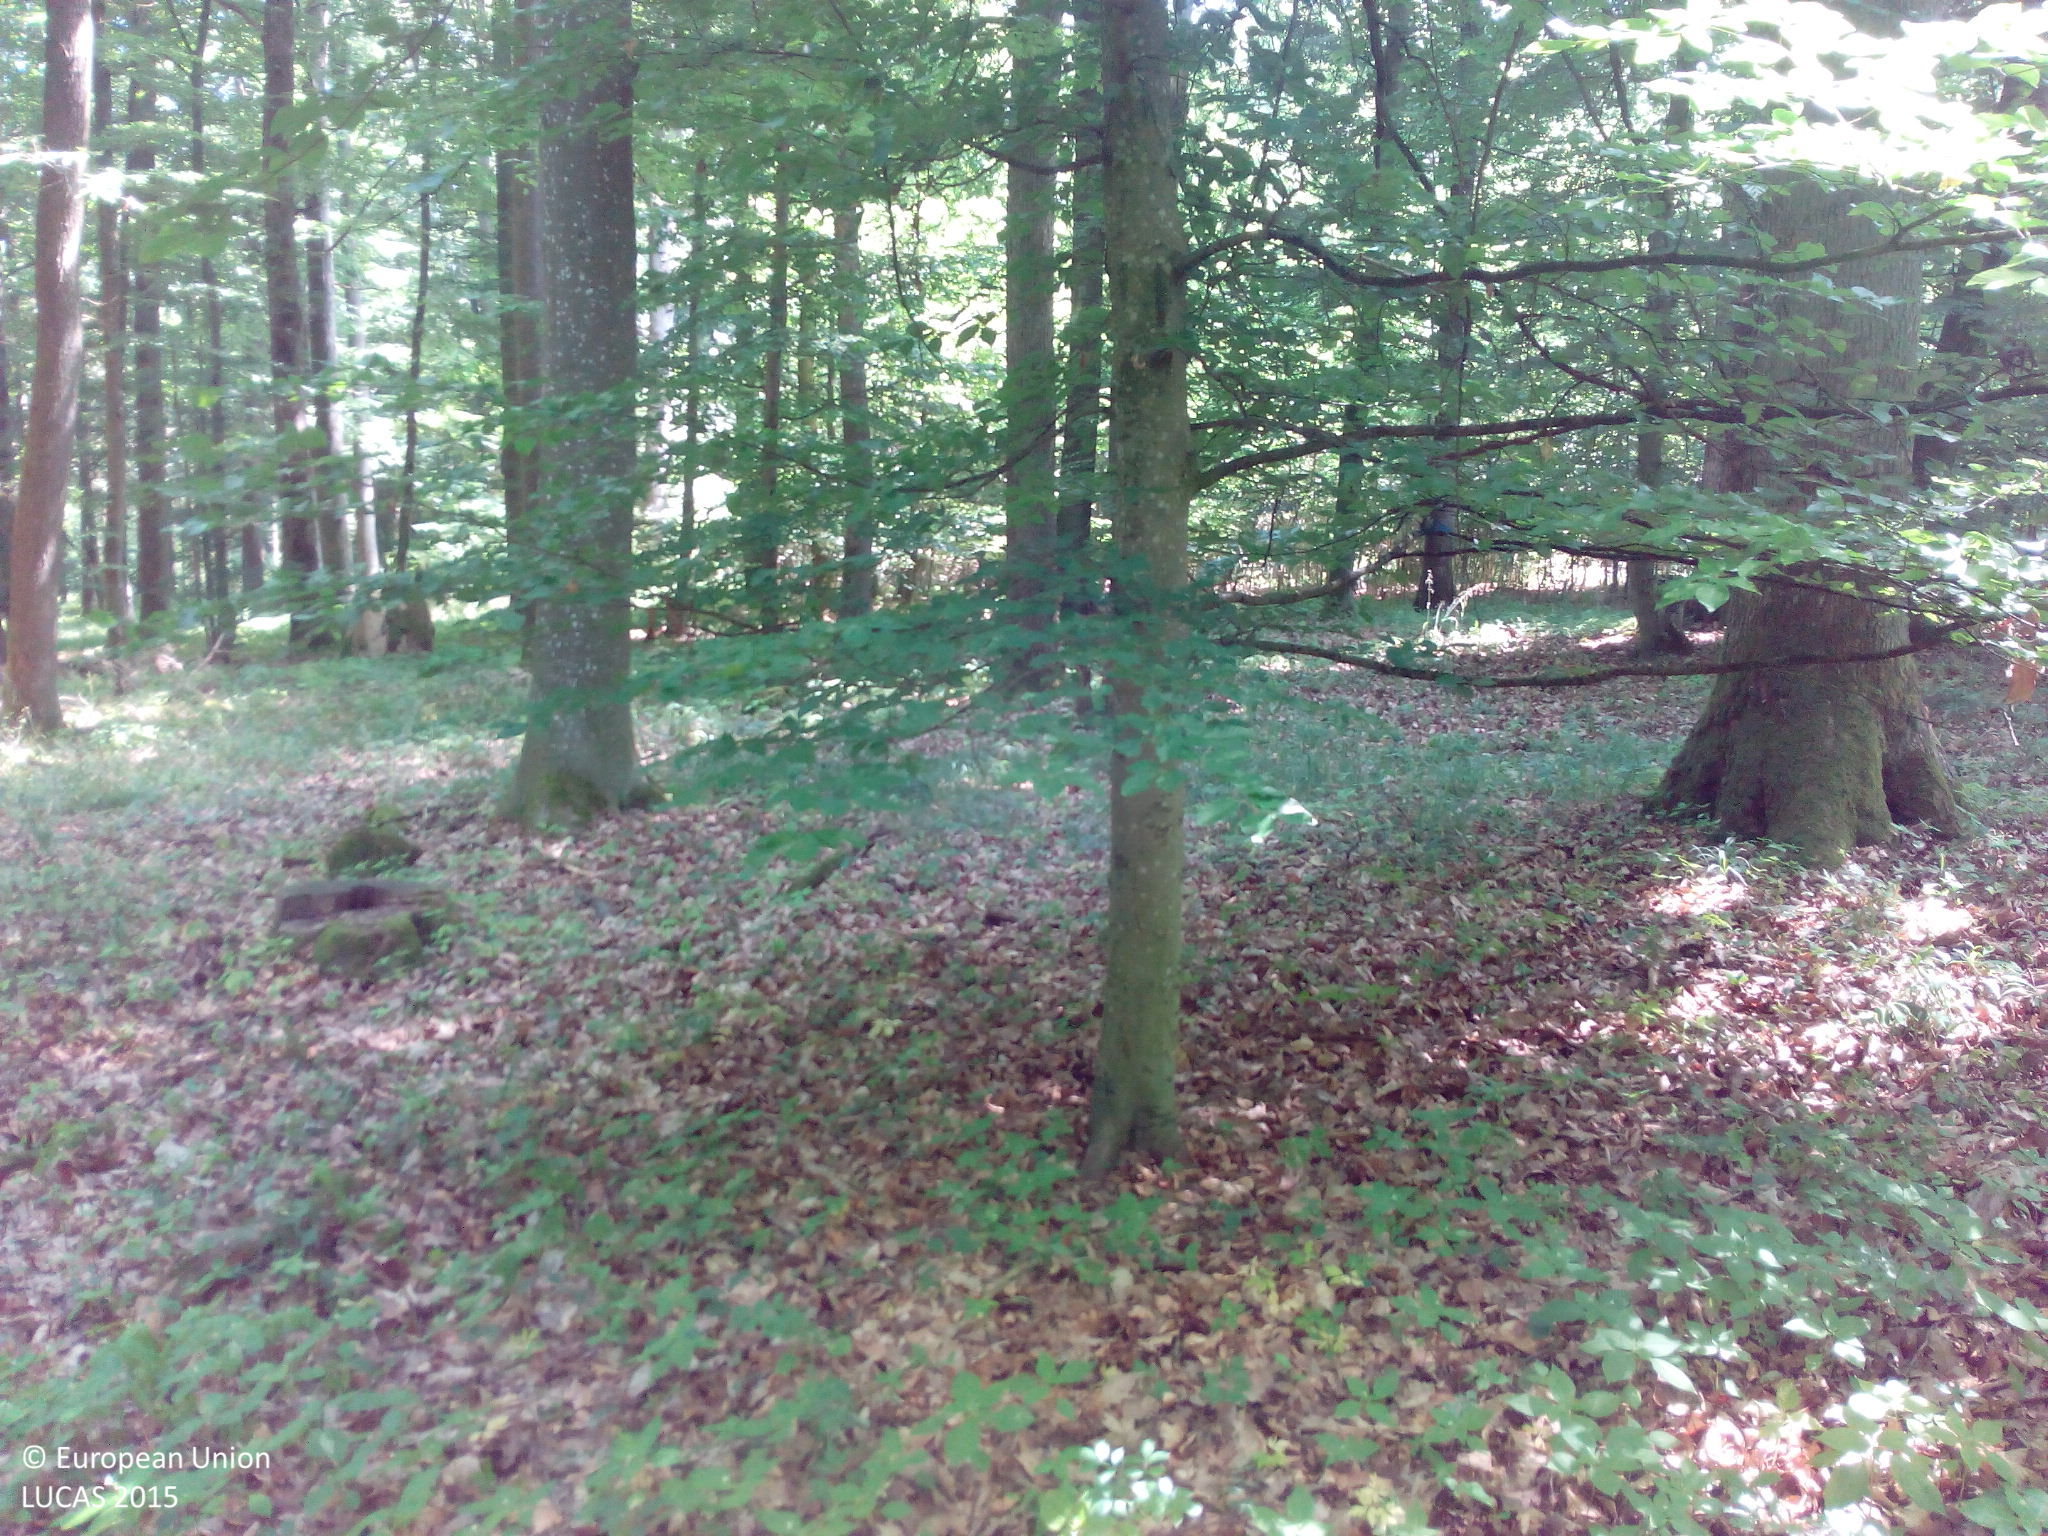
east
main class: Woodland
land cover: Broadleaved woodland
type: mesophytic deciduous forest
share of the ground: > 75 %
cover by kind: broadleaved forest trees 90 %, herbaceous plants 10 %
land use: Forestry
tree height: > 5 m
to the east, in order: Broadleaved woodland; Tracks; Broadleaved woodland; Tracks; Broadleaved woodland
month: July
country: DE
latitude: 49.5368
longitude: 9.9309
